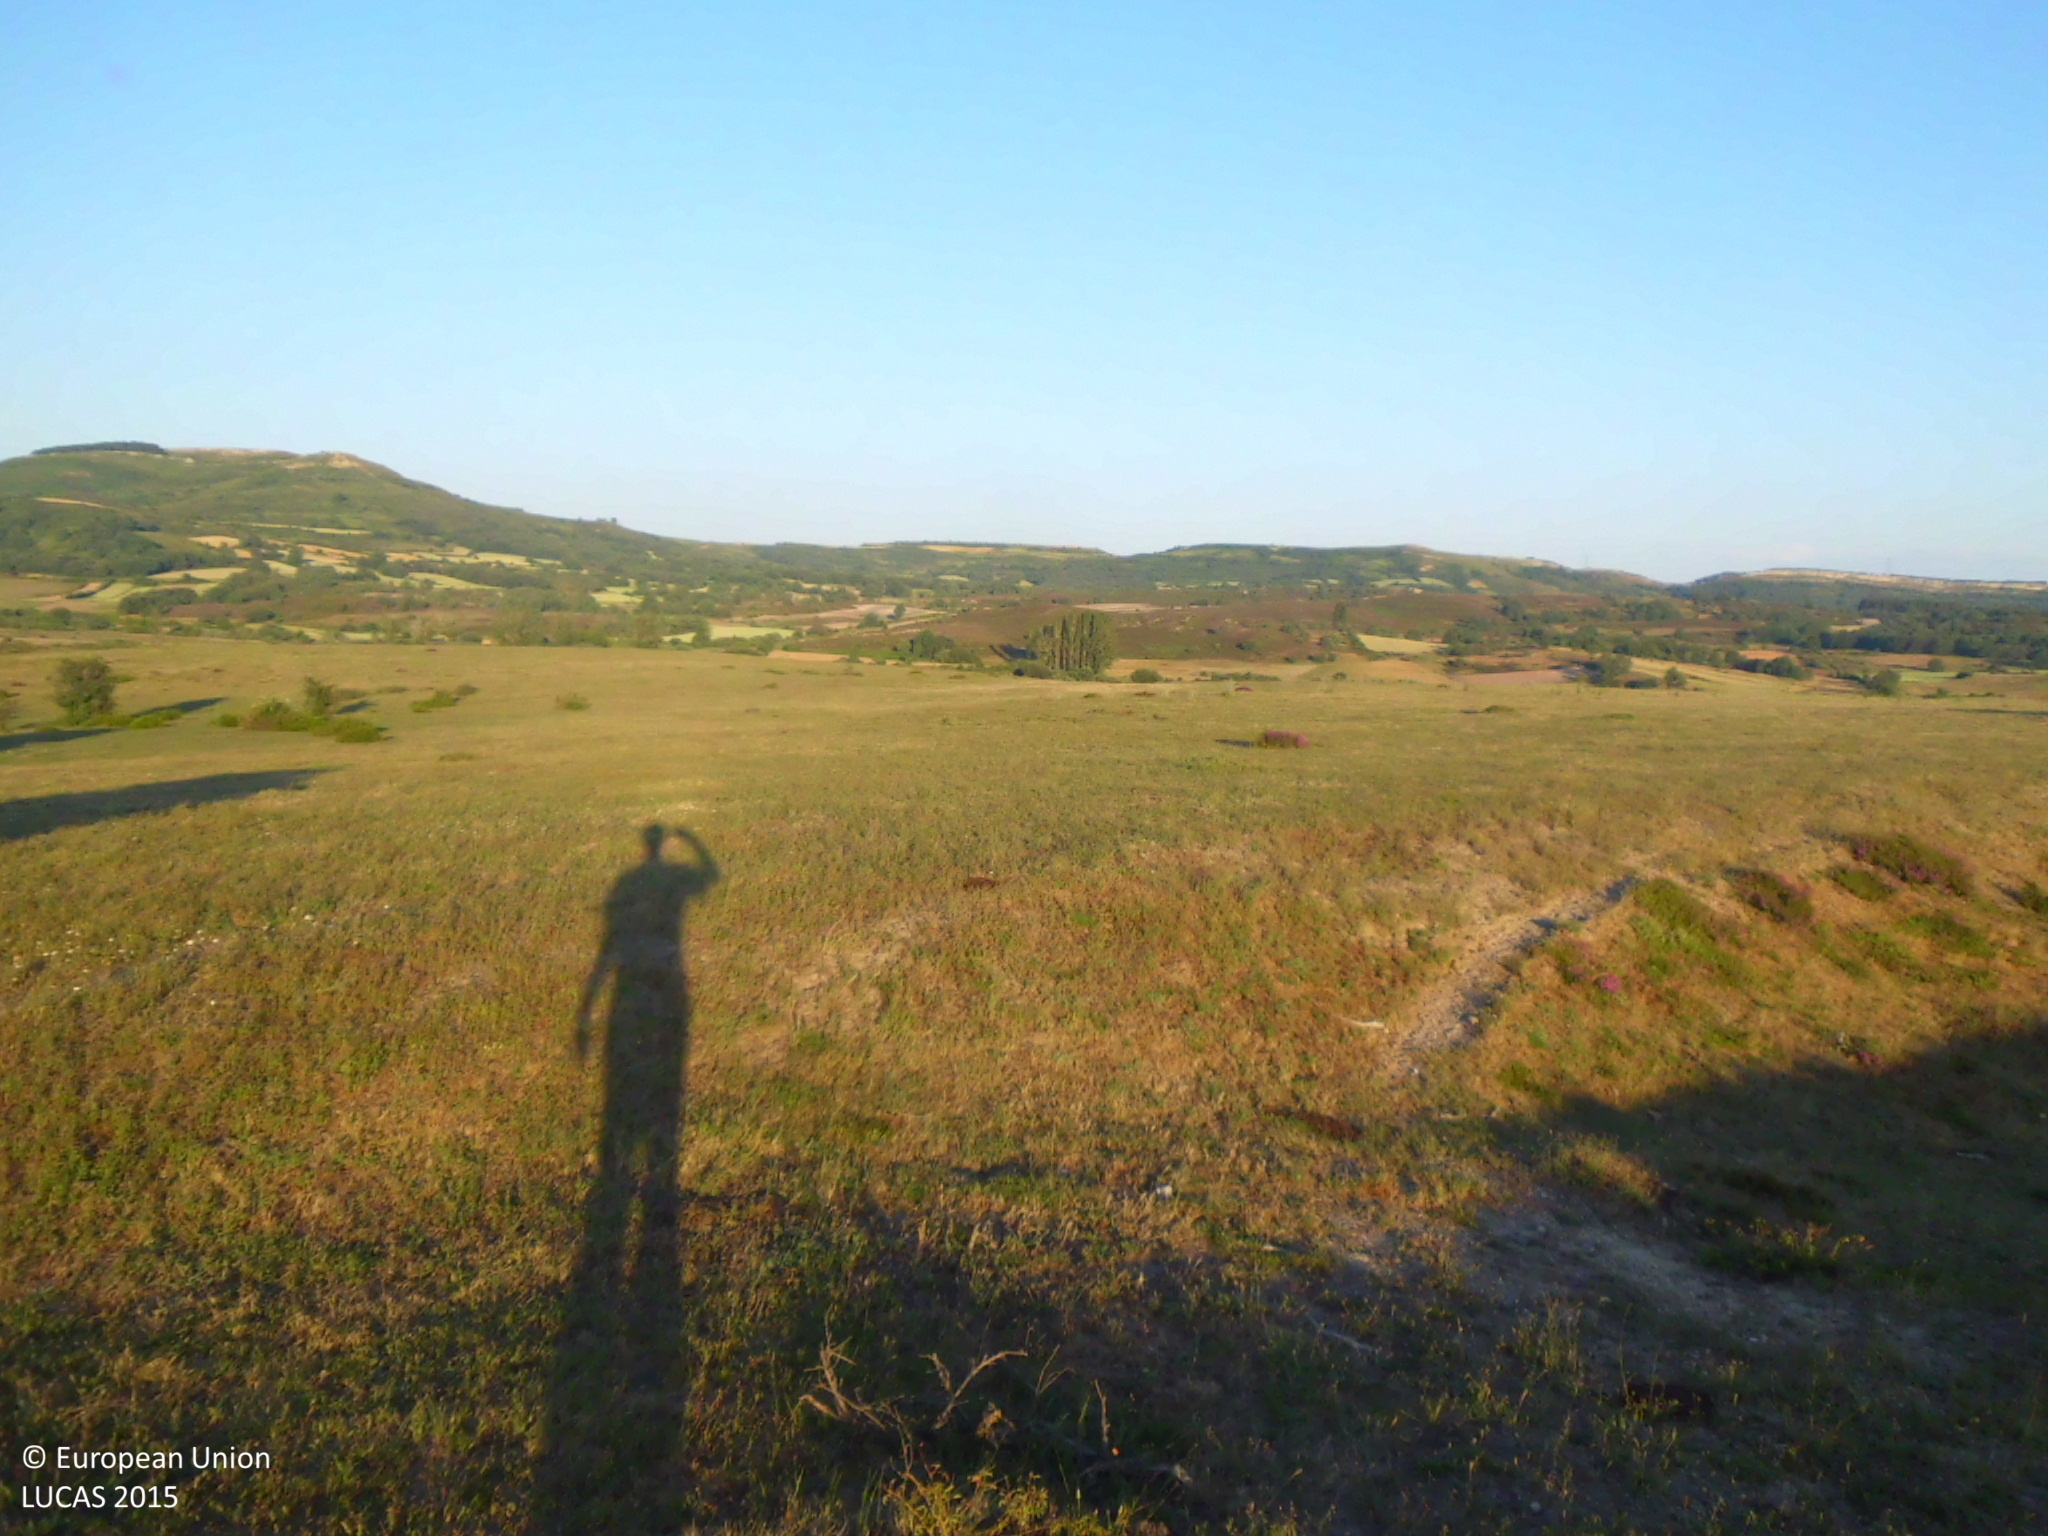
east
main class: Grassland
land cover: Grassland without tree/shrub cover
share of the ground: > 75 %
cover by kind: herbaceous plants 85 %, consolidated bare surface 15 %
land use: Agriculture (excluding fallow land and kitchen gardens)
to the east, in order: Grassland without tree/shrub cover; Grassland with sparse tree/shrub cover; Grassland without tree/shrub cover
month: June
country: ES
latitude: 42.6127
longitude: -3.9771
